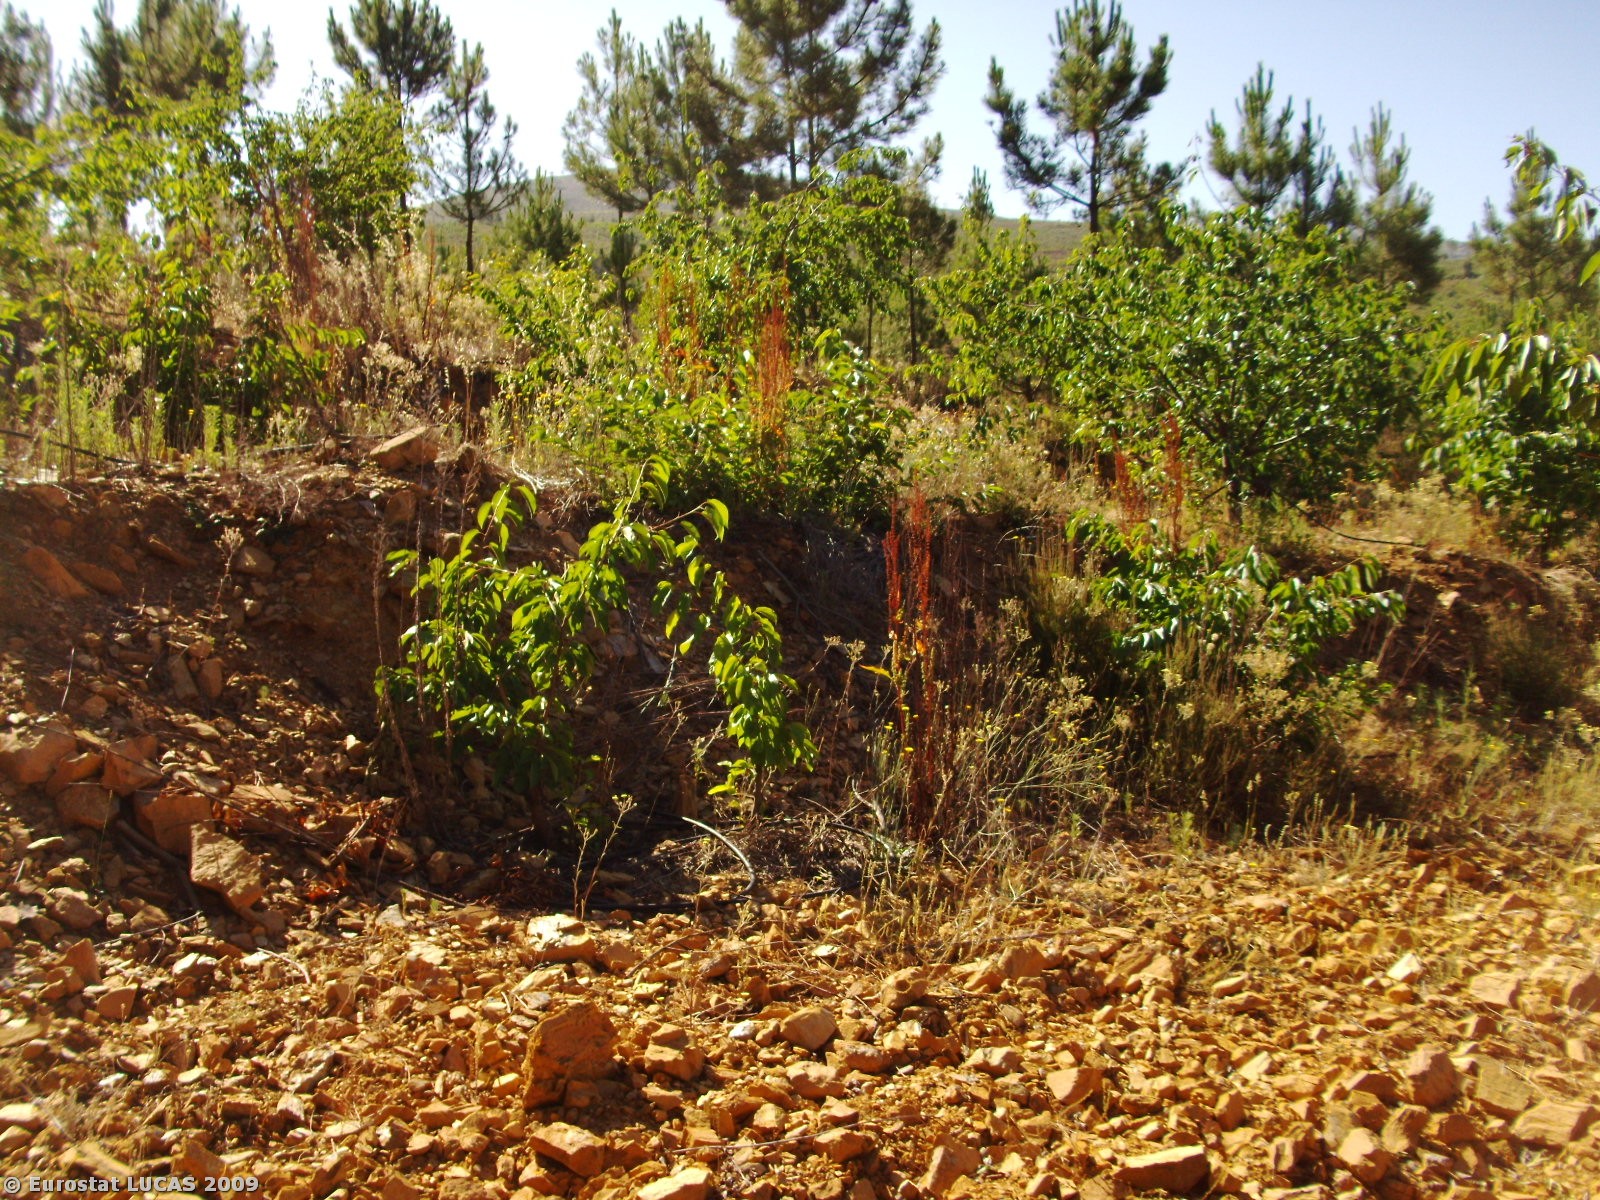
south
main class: Woodland
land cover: Coniferous woodland
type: coniferous forest of the mediterranean region
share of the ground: > 75 %
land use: Forestry
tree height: > 5 m
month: June
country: PT
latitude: 40.1110
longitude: -7.5515
